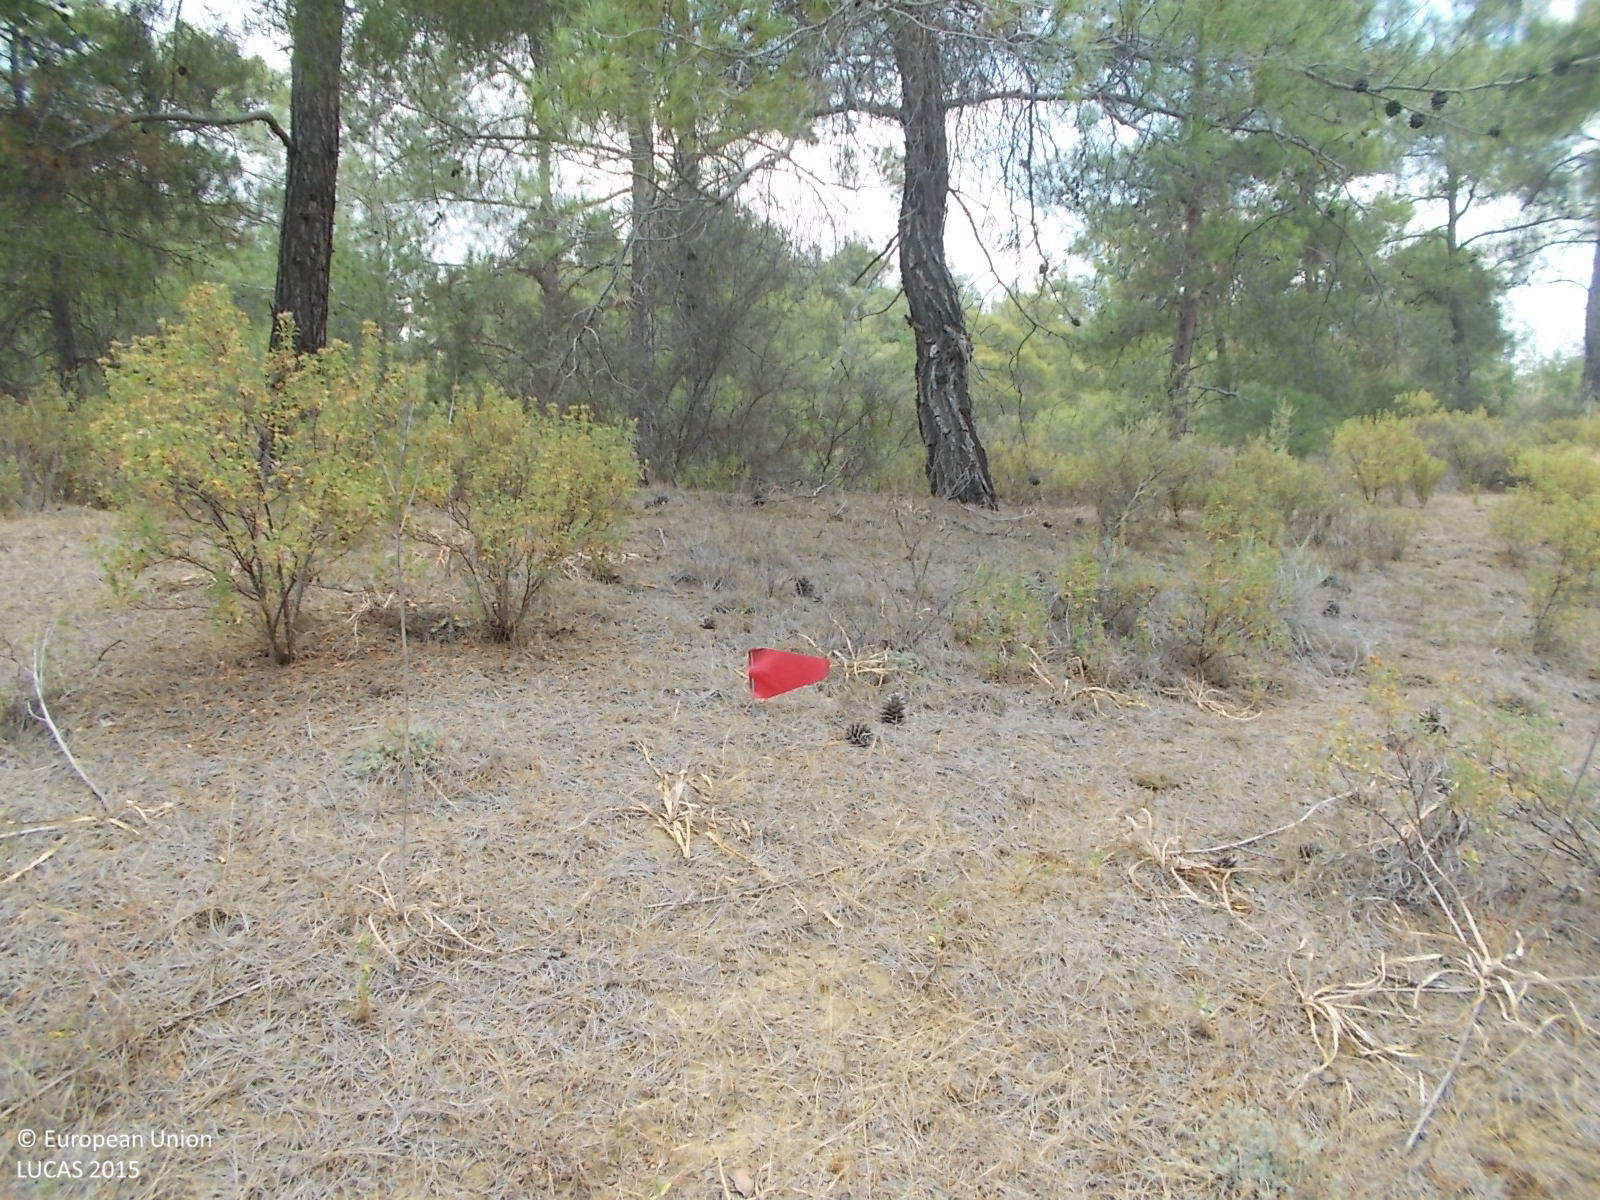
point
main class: Woodland
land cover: Pine dominated coniferous woodland
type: coniferous forest of the mediterranean region
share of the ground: 50 - 75 %
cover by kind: coniferous forest trees 70 %, unconsolidated bare surface 20 %, shrubs 10 %
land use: Forestry
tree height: > 5 m
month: June
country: CY
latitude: 34.8932
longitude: 32.7574
